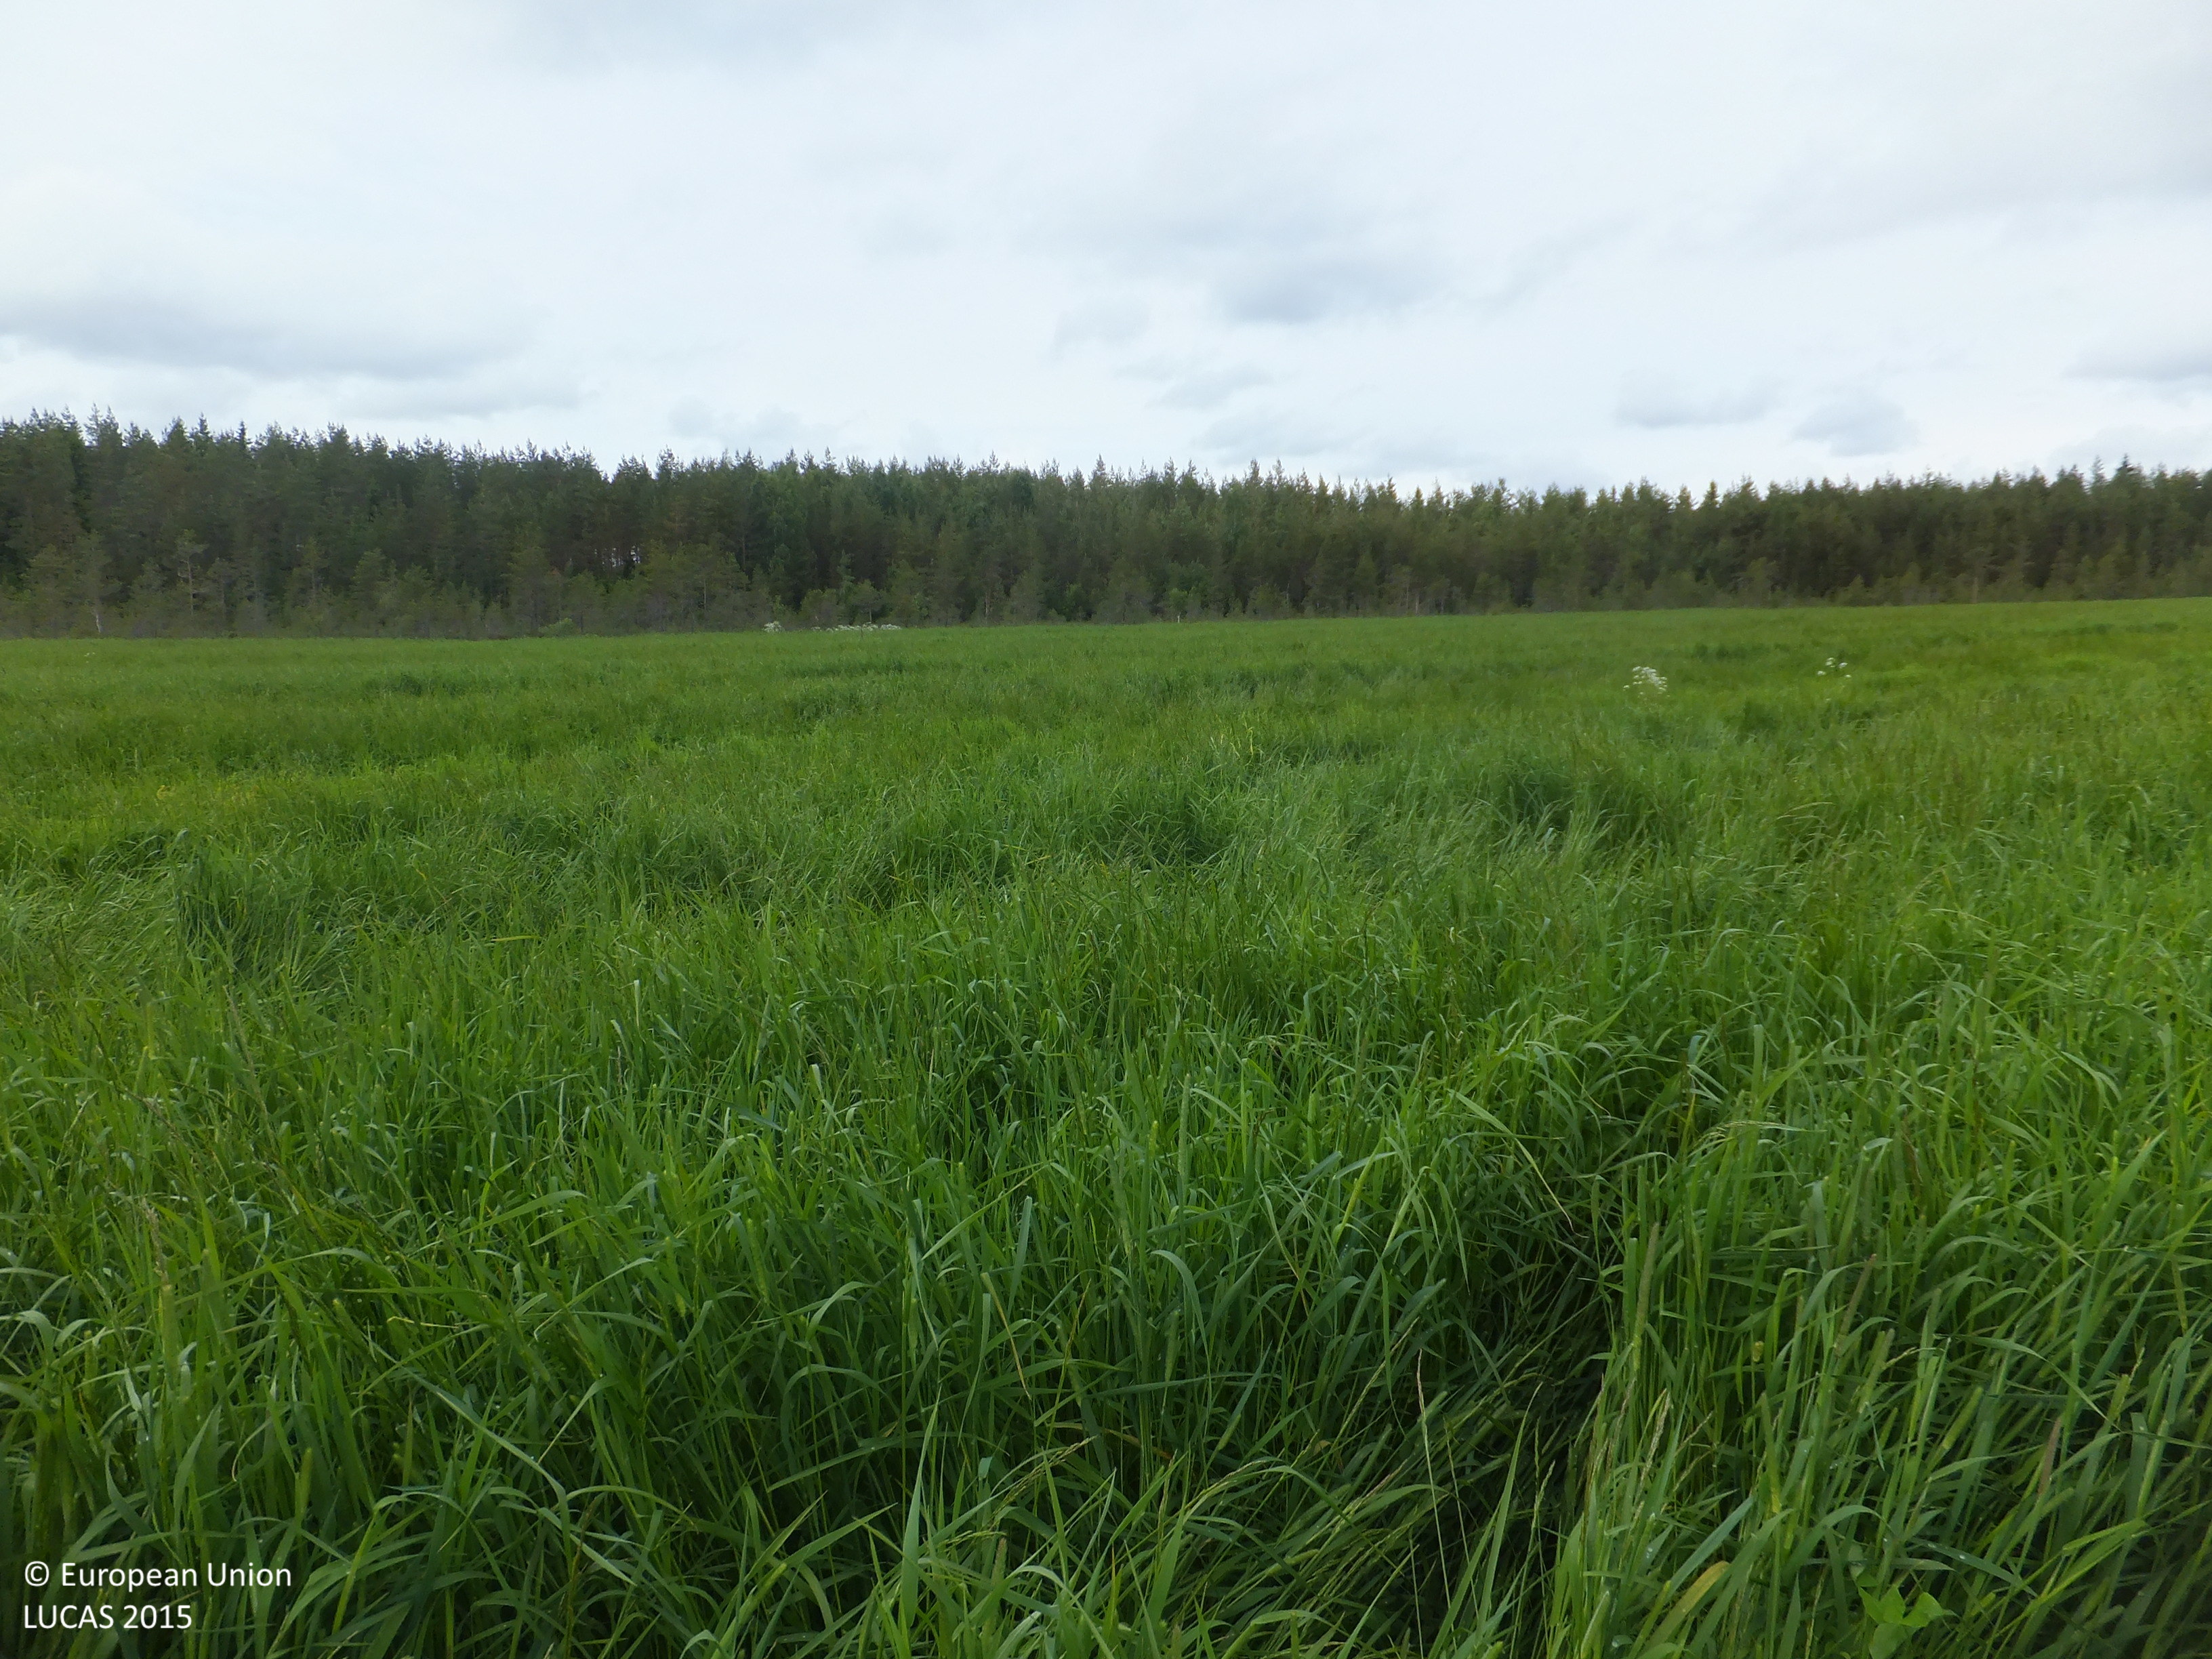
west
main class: Cropland
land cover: Temporary grasslands
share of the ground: > 75 %
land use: Agriculture (excluding fallow land and kitchen gardens)
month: June
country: FI
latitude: 63.3188
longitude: 23.9446
